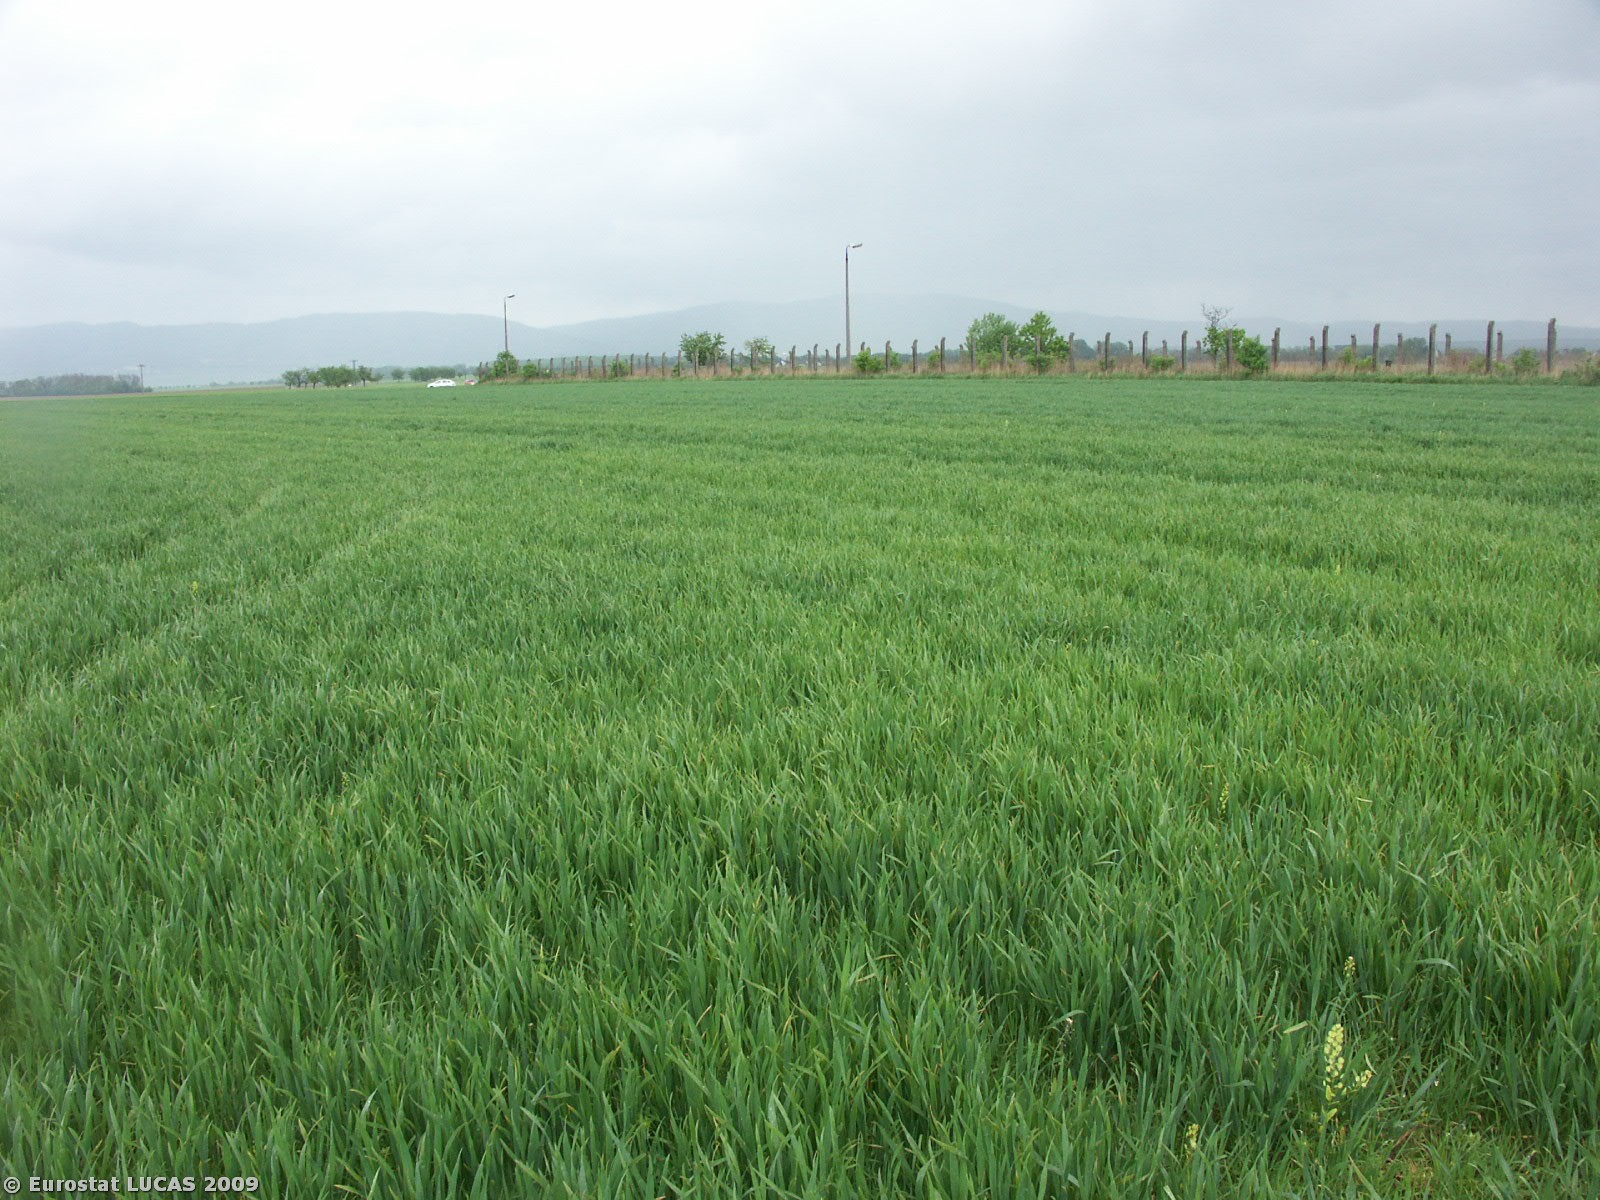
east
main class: Cropland
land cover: Common wheat
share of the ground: > 75 %
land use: Agriculture (excluding fallow land and kitchen gardens)
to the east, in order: Common wheat; Electric lines; Common wheat; Fences; Shrubland with sparse tree cover; Railways; Broadleaved woodland; Fences; Common wheat; Grass margins; Ditches and canals; Paved roads, cycling and walking lanes; Grass margins; Ditches and canals; Barley
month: May
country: CZ
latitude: 49.7783
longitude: 17.1623
